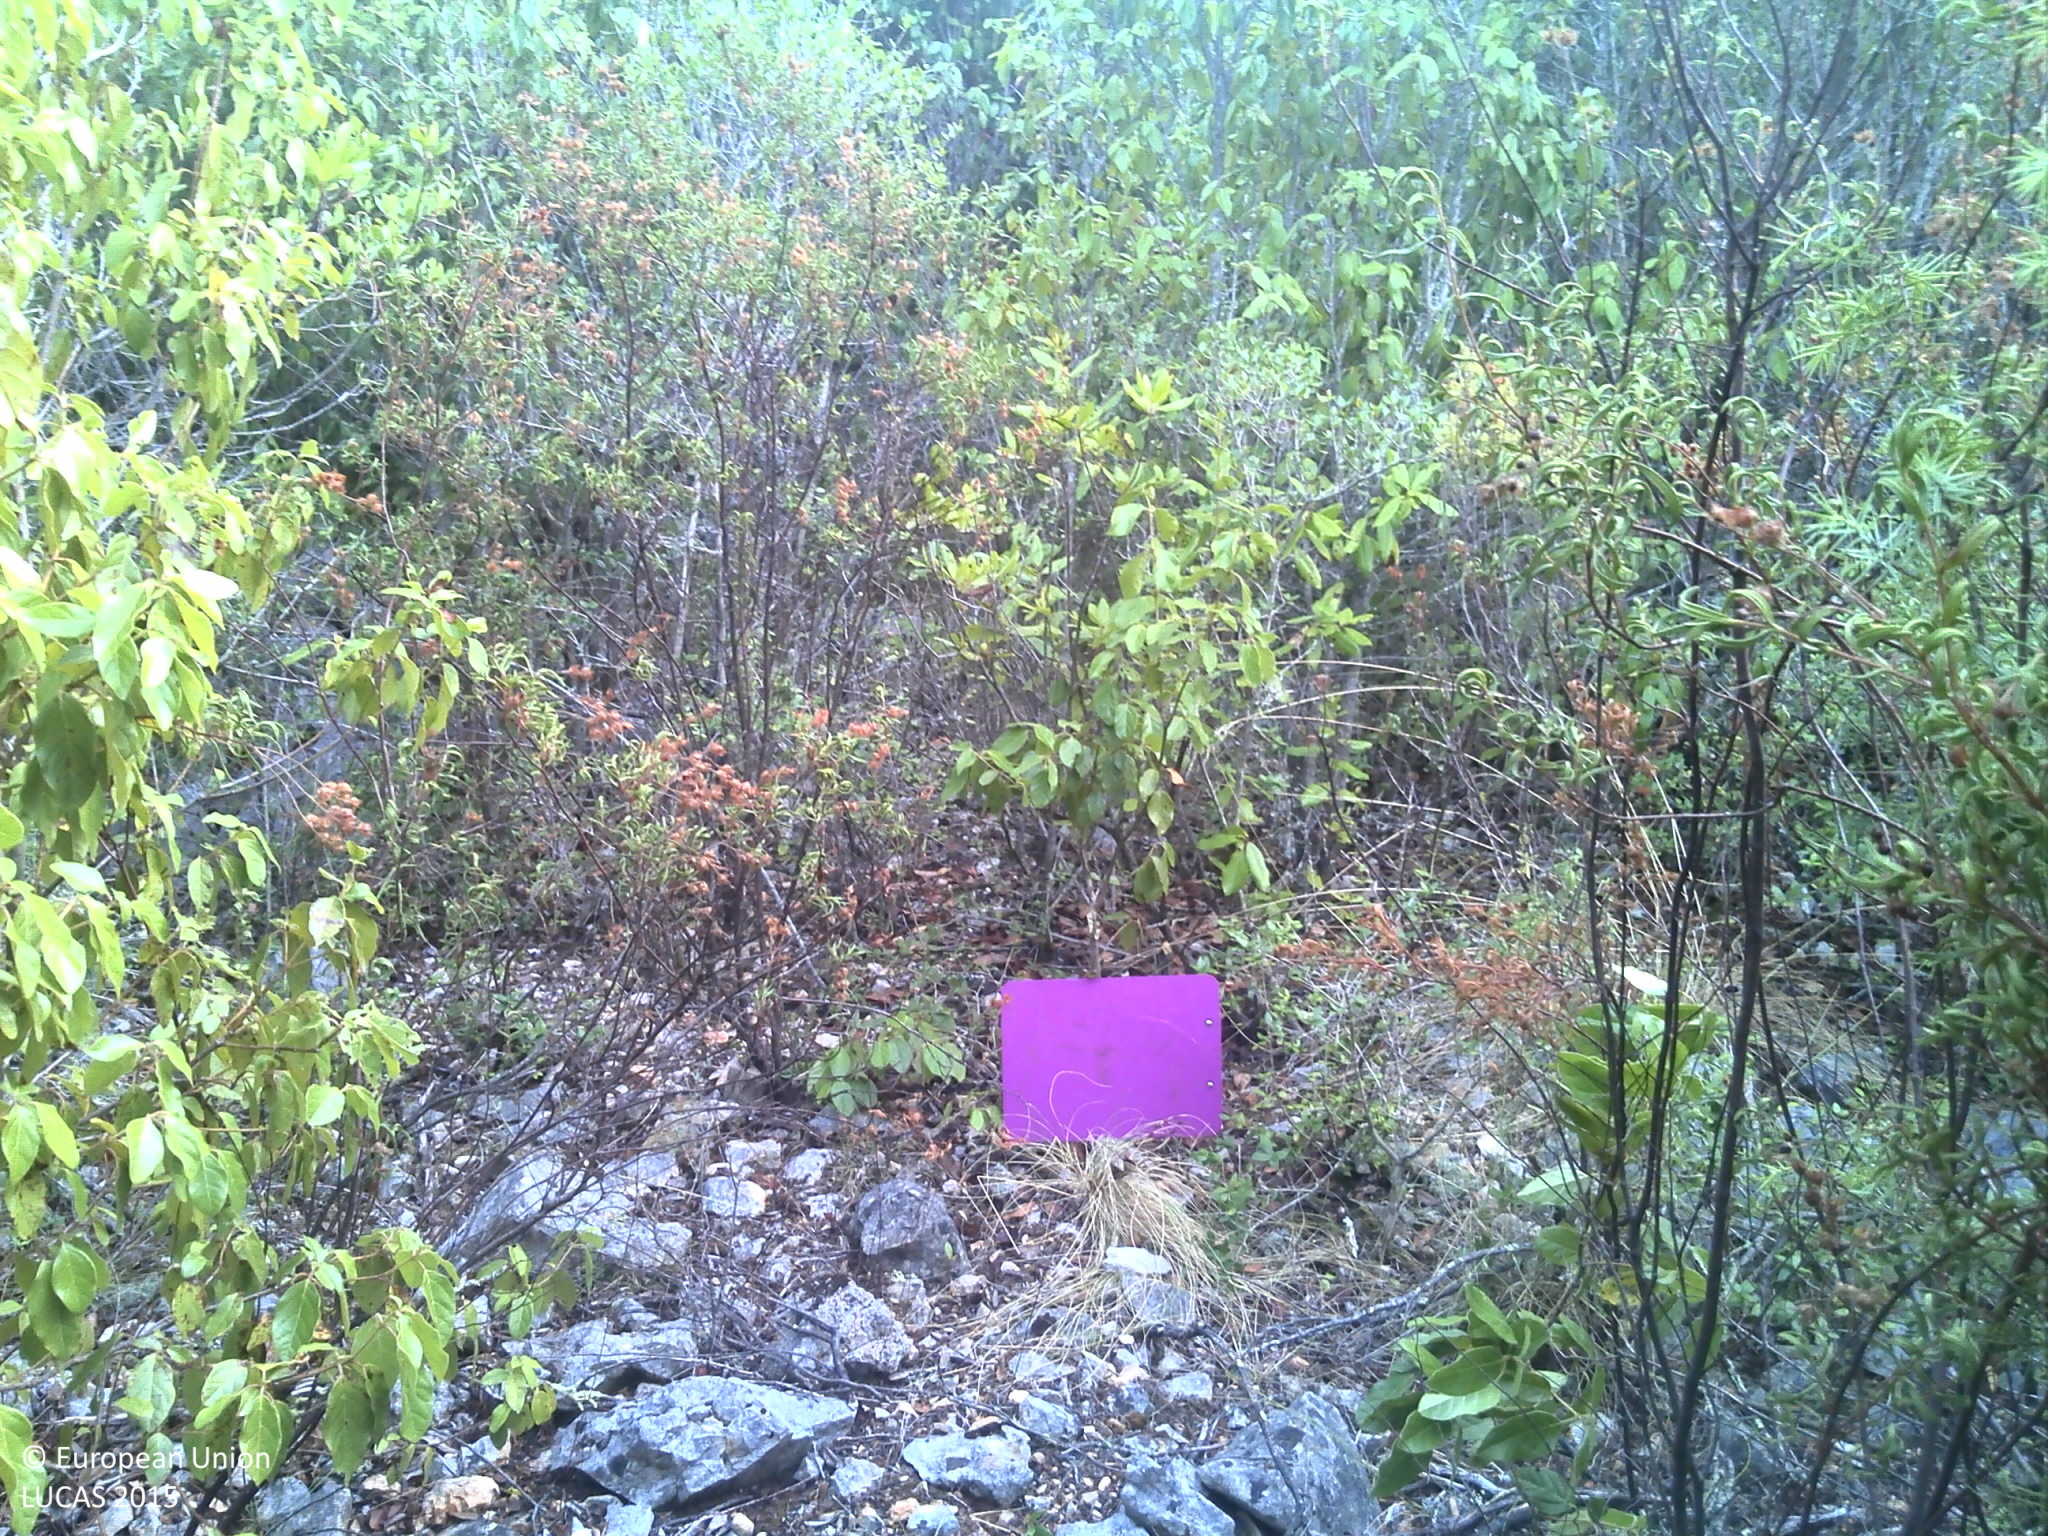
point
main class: Shrubland
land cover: Shrubland with sparse tree cover
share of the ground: > 75 %
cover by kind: shrubs 90 %, coniferous forest trees 5 %, consolidated bare surface 5 %
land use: Semi-natural and natural areas not in use
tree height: < 5 m
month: September
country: HR
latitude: 43.9919
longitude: 15.0665
